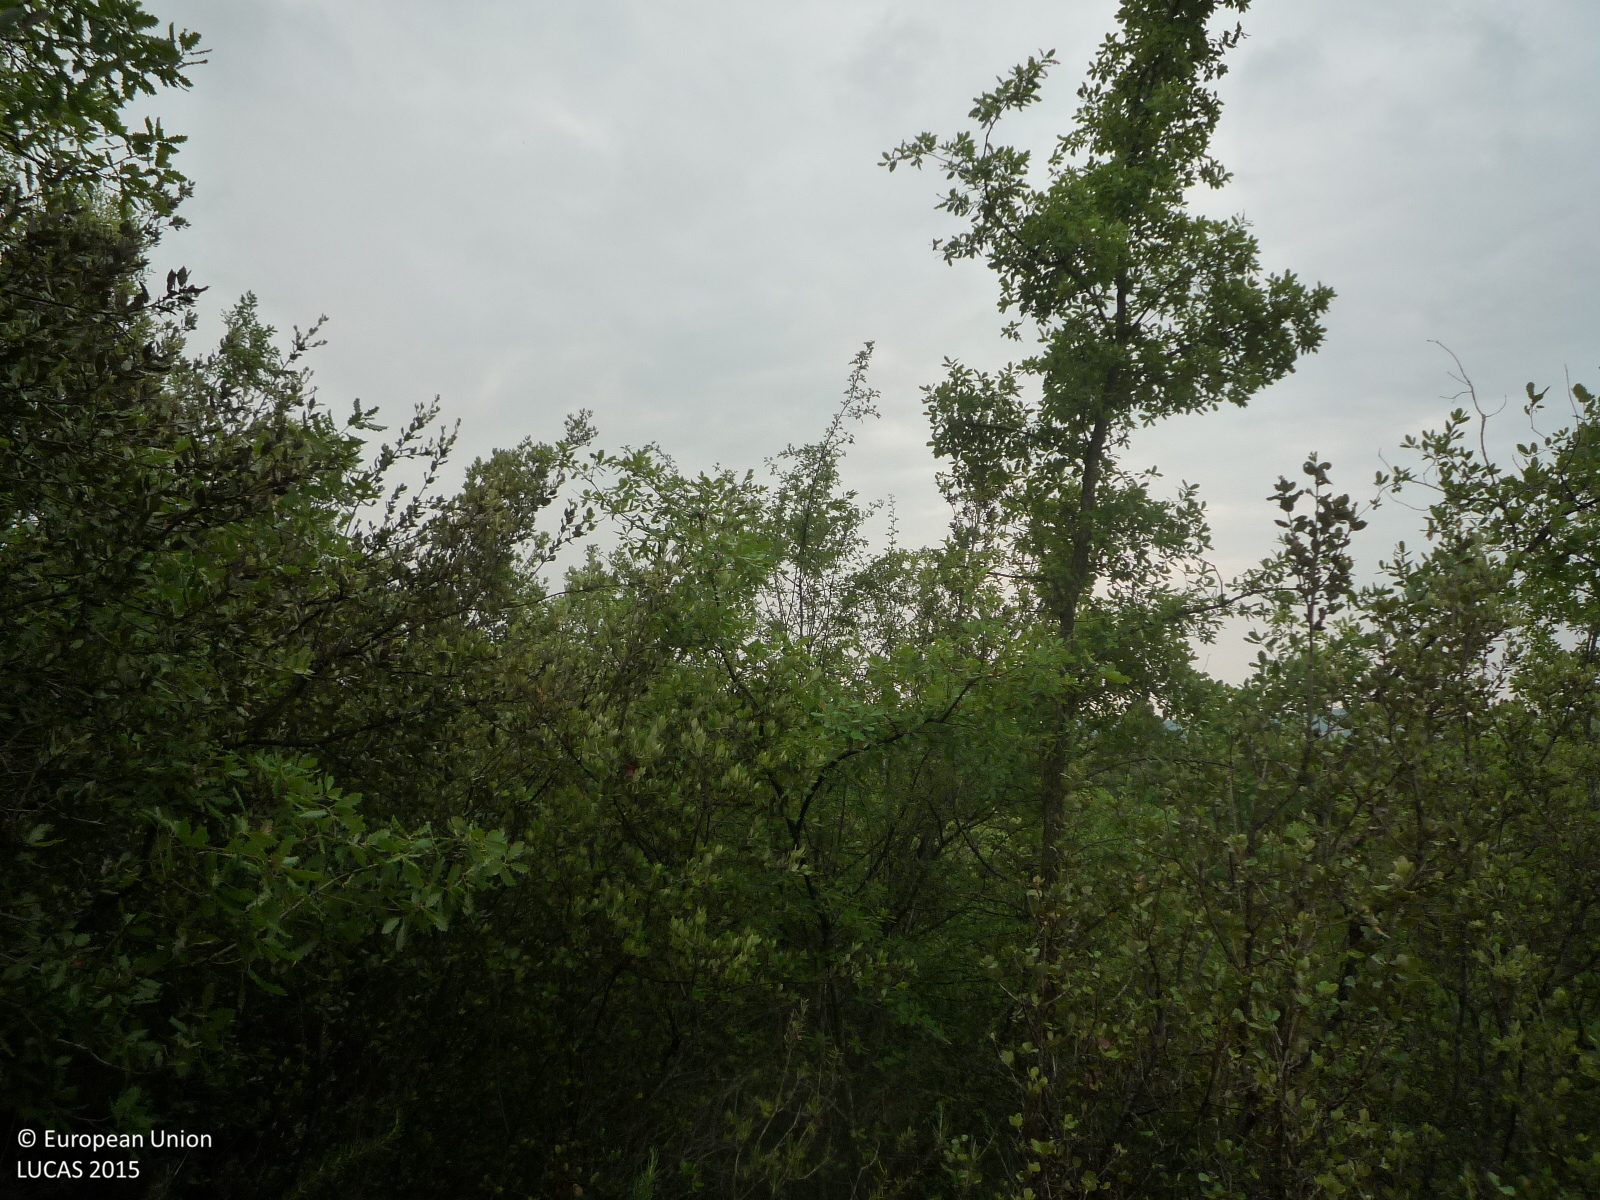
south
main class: Woodland
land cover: Broadleaved woodland
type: broadleaved evergreen forest
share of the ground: > 75 %
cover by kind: broadleaved forest trees 80 %, herbaceous plants 20 %
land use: Forestry
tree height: < 5 m
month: June
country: ES
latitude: 42.0594
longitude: 1.9291
